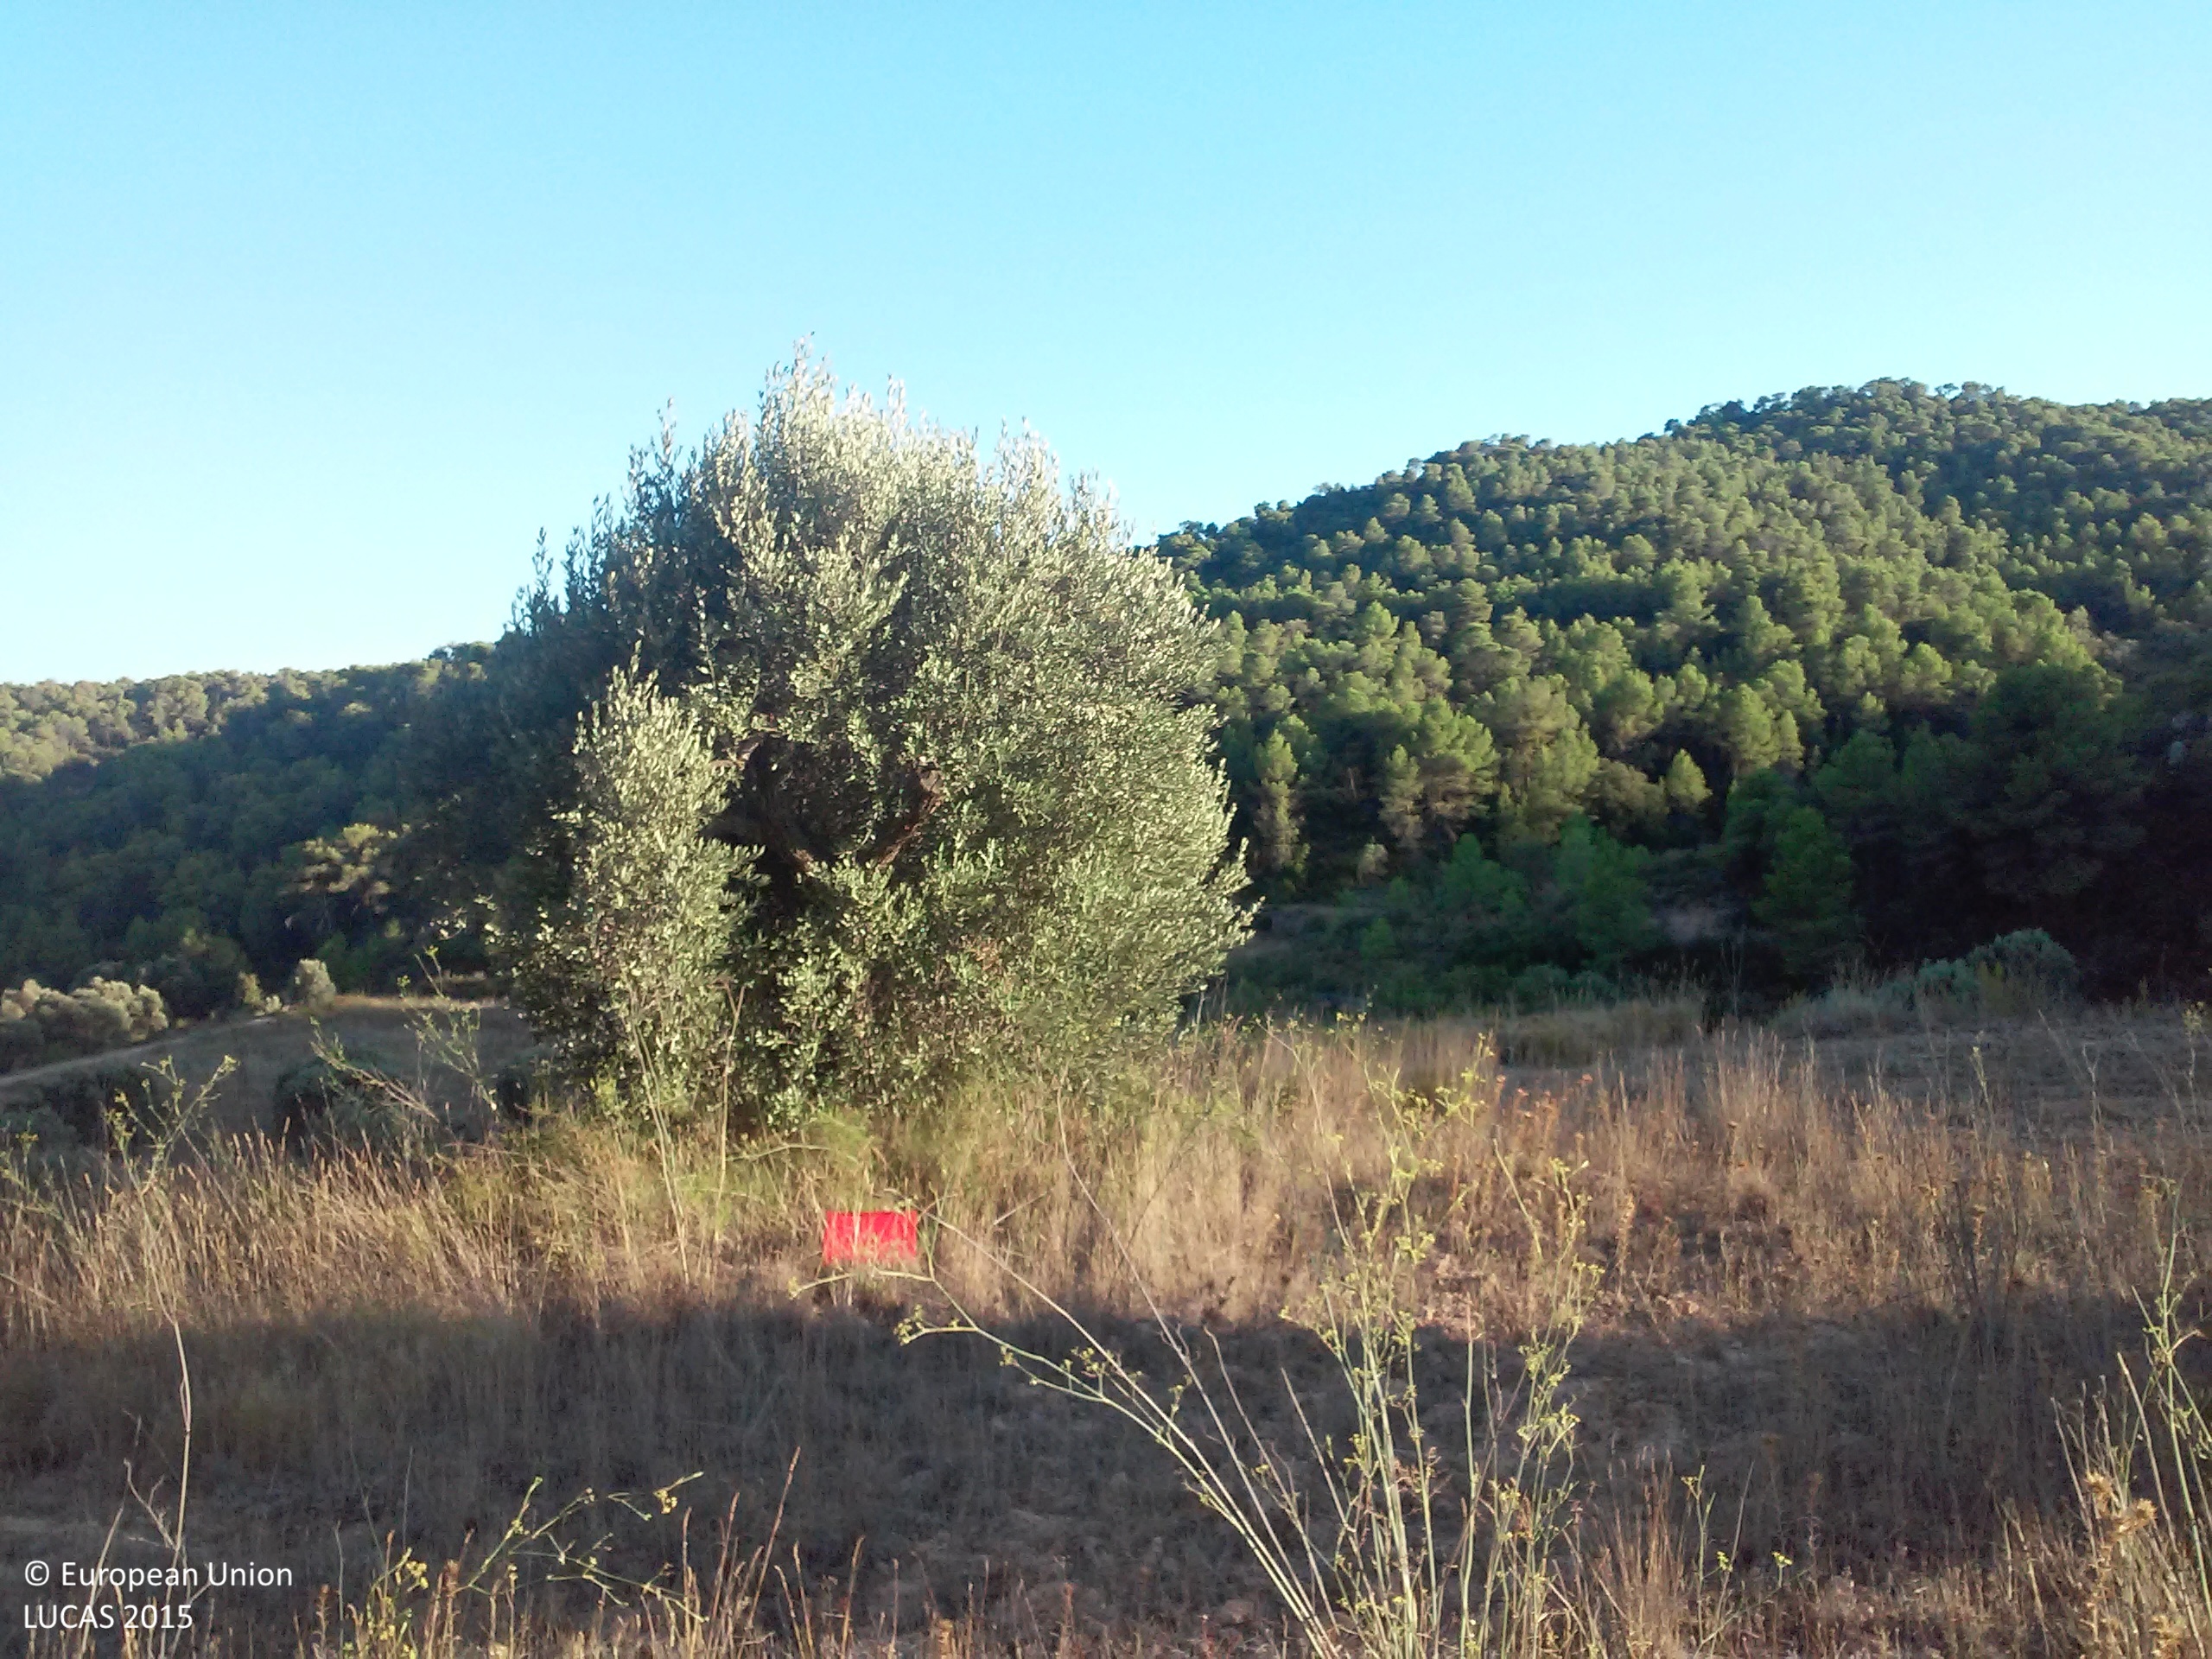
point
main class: Cropland
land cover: Olive groves
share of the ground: 10 - 25 %
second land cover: Grassland without tree/shrub cover
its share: > 75 %
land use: Agriculture (excluding fallow land and kitchen gardens)
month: August
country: ES
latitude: 41.2815
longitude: 0.5219
